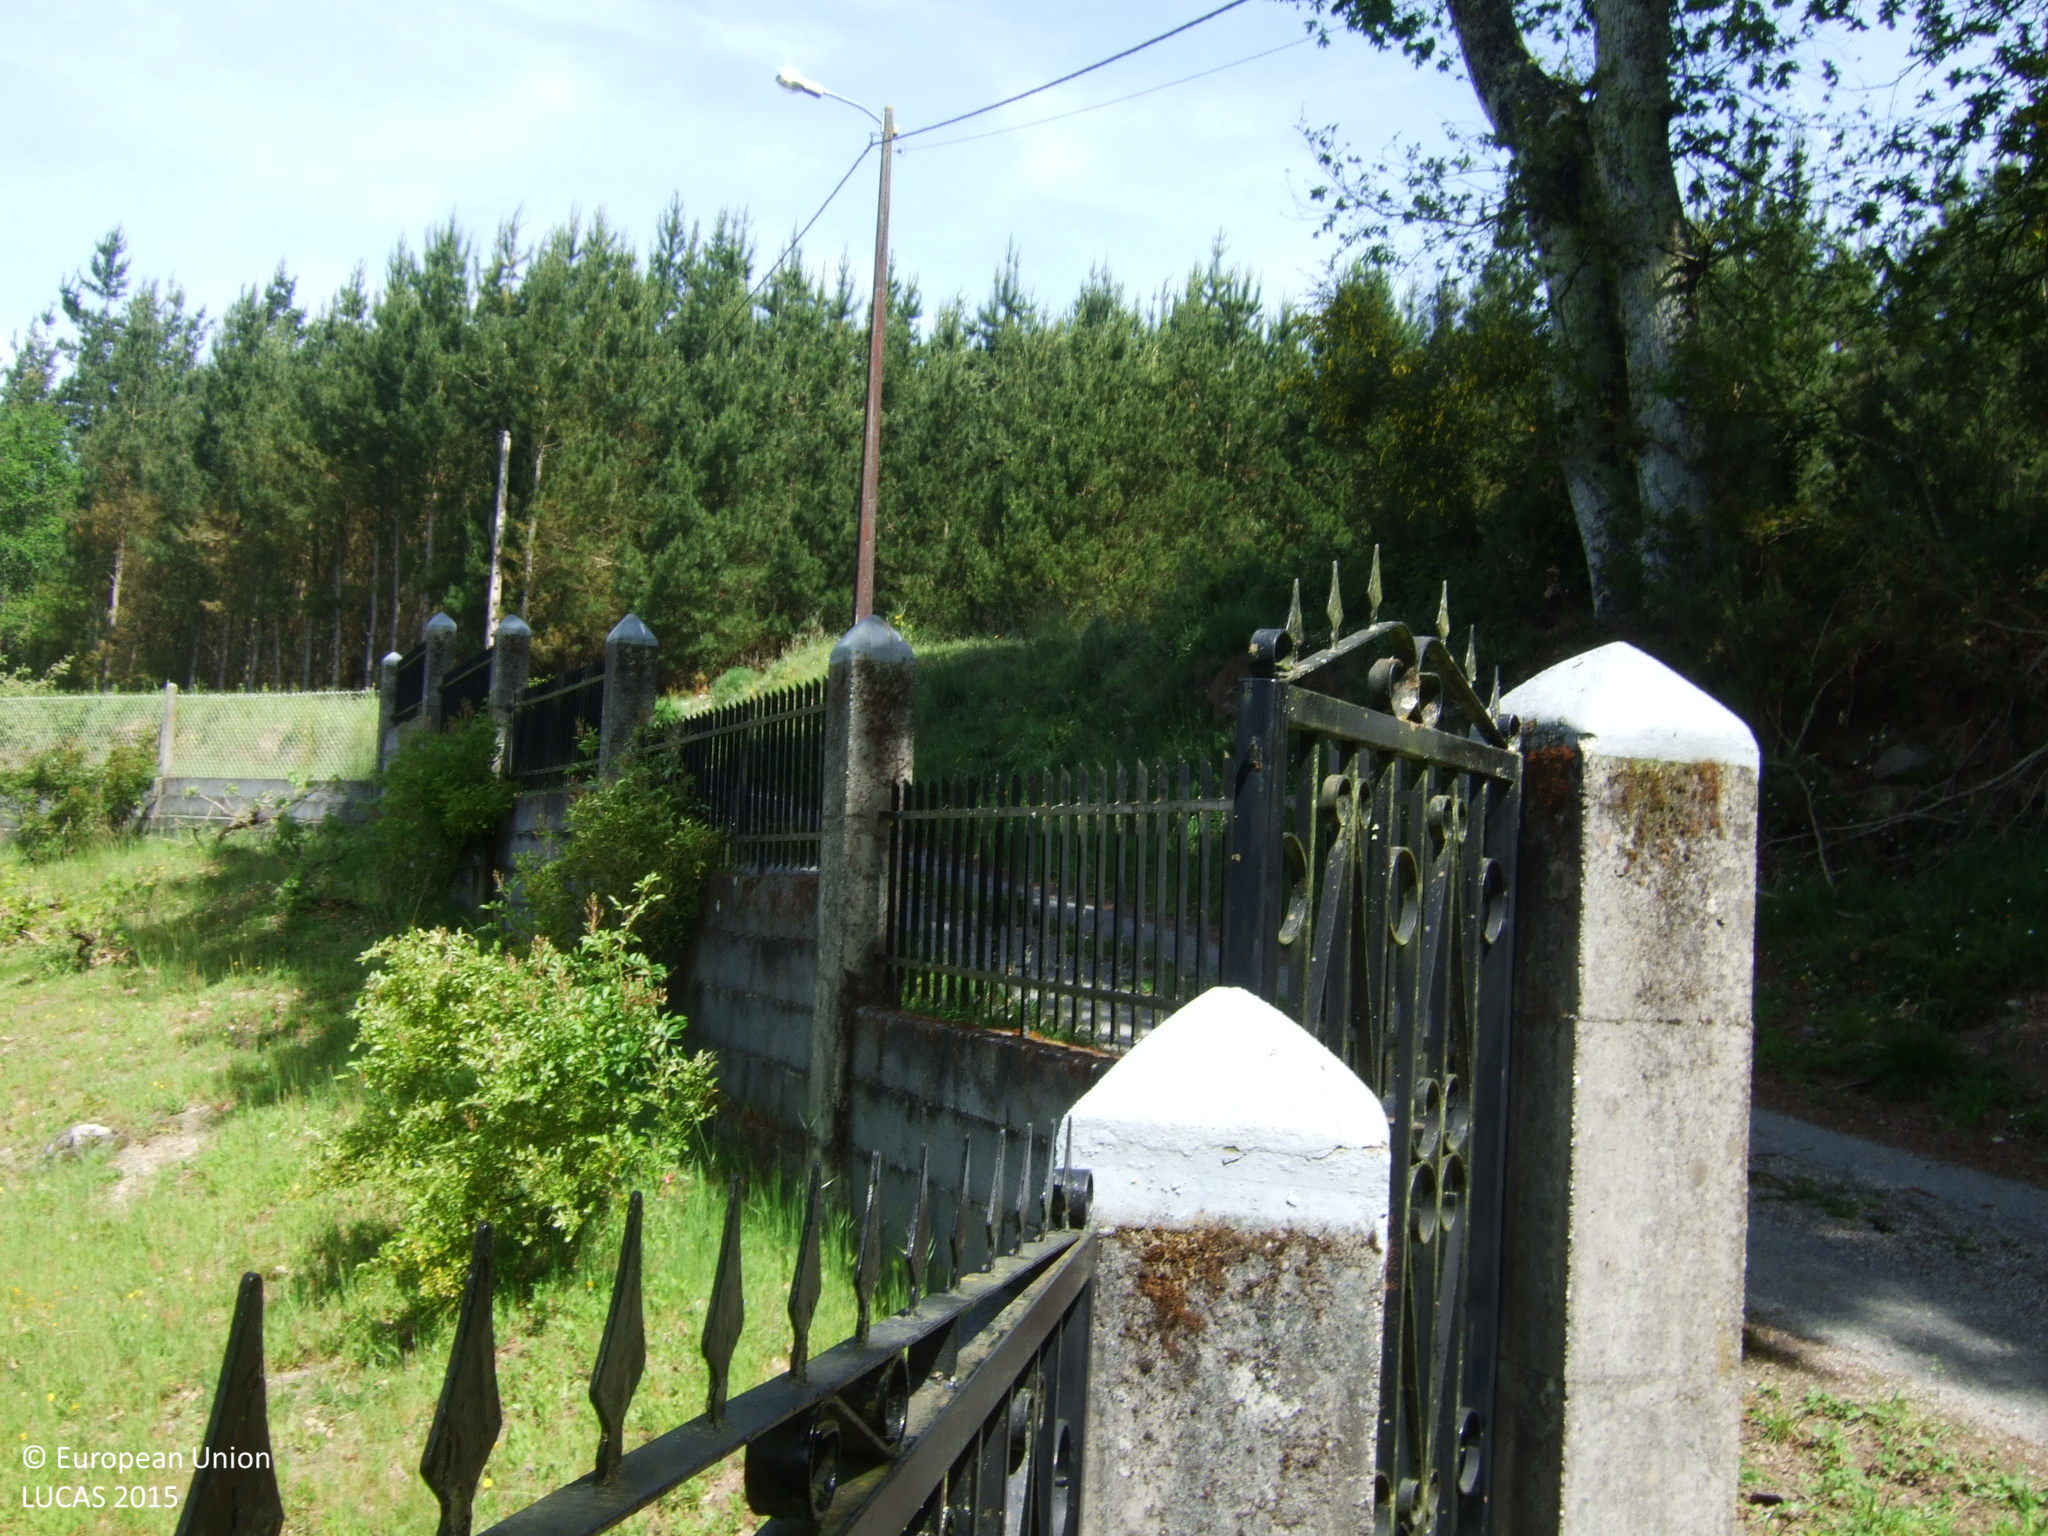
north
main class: Cropland
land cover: Apple fruit
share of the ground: 10 - 25 %
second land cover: Grassland without tree/shrub cover
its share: > 75 %
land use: Kitchen garden
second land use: Residential
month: May
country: ES
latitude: 42.9639
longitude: -7.3697
